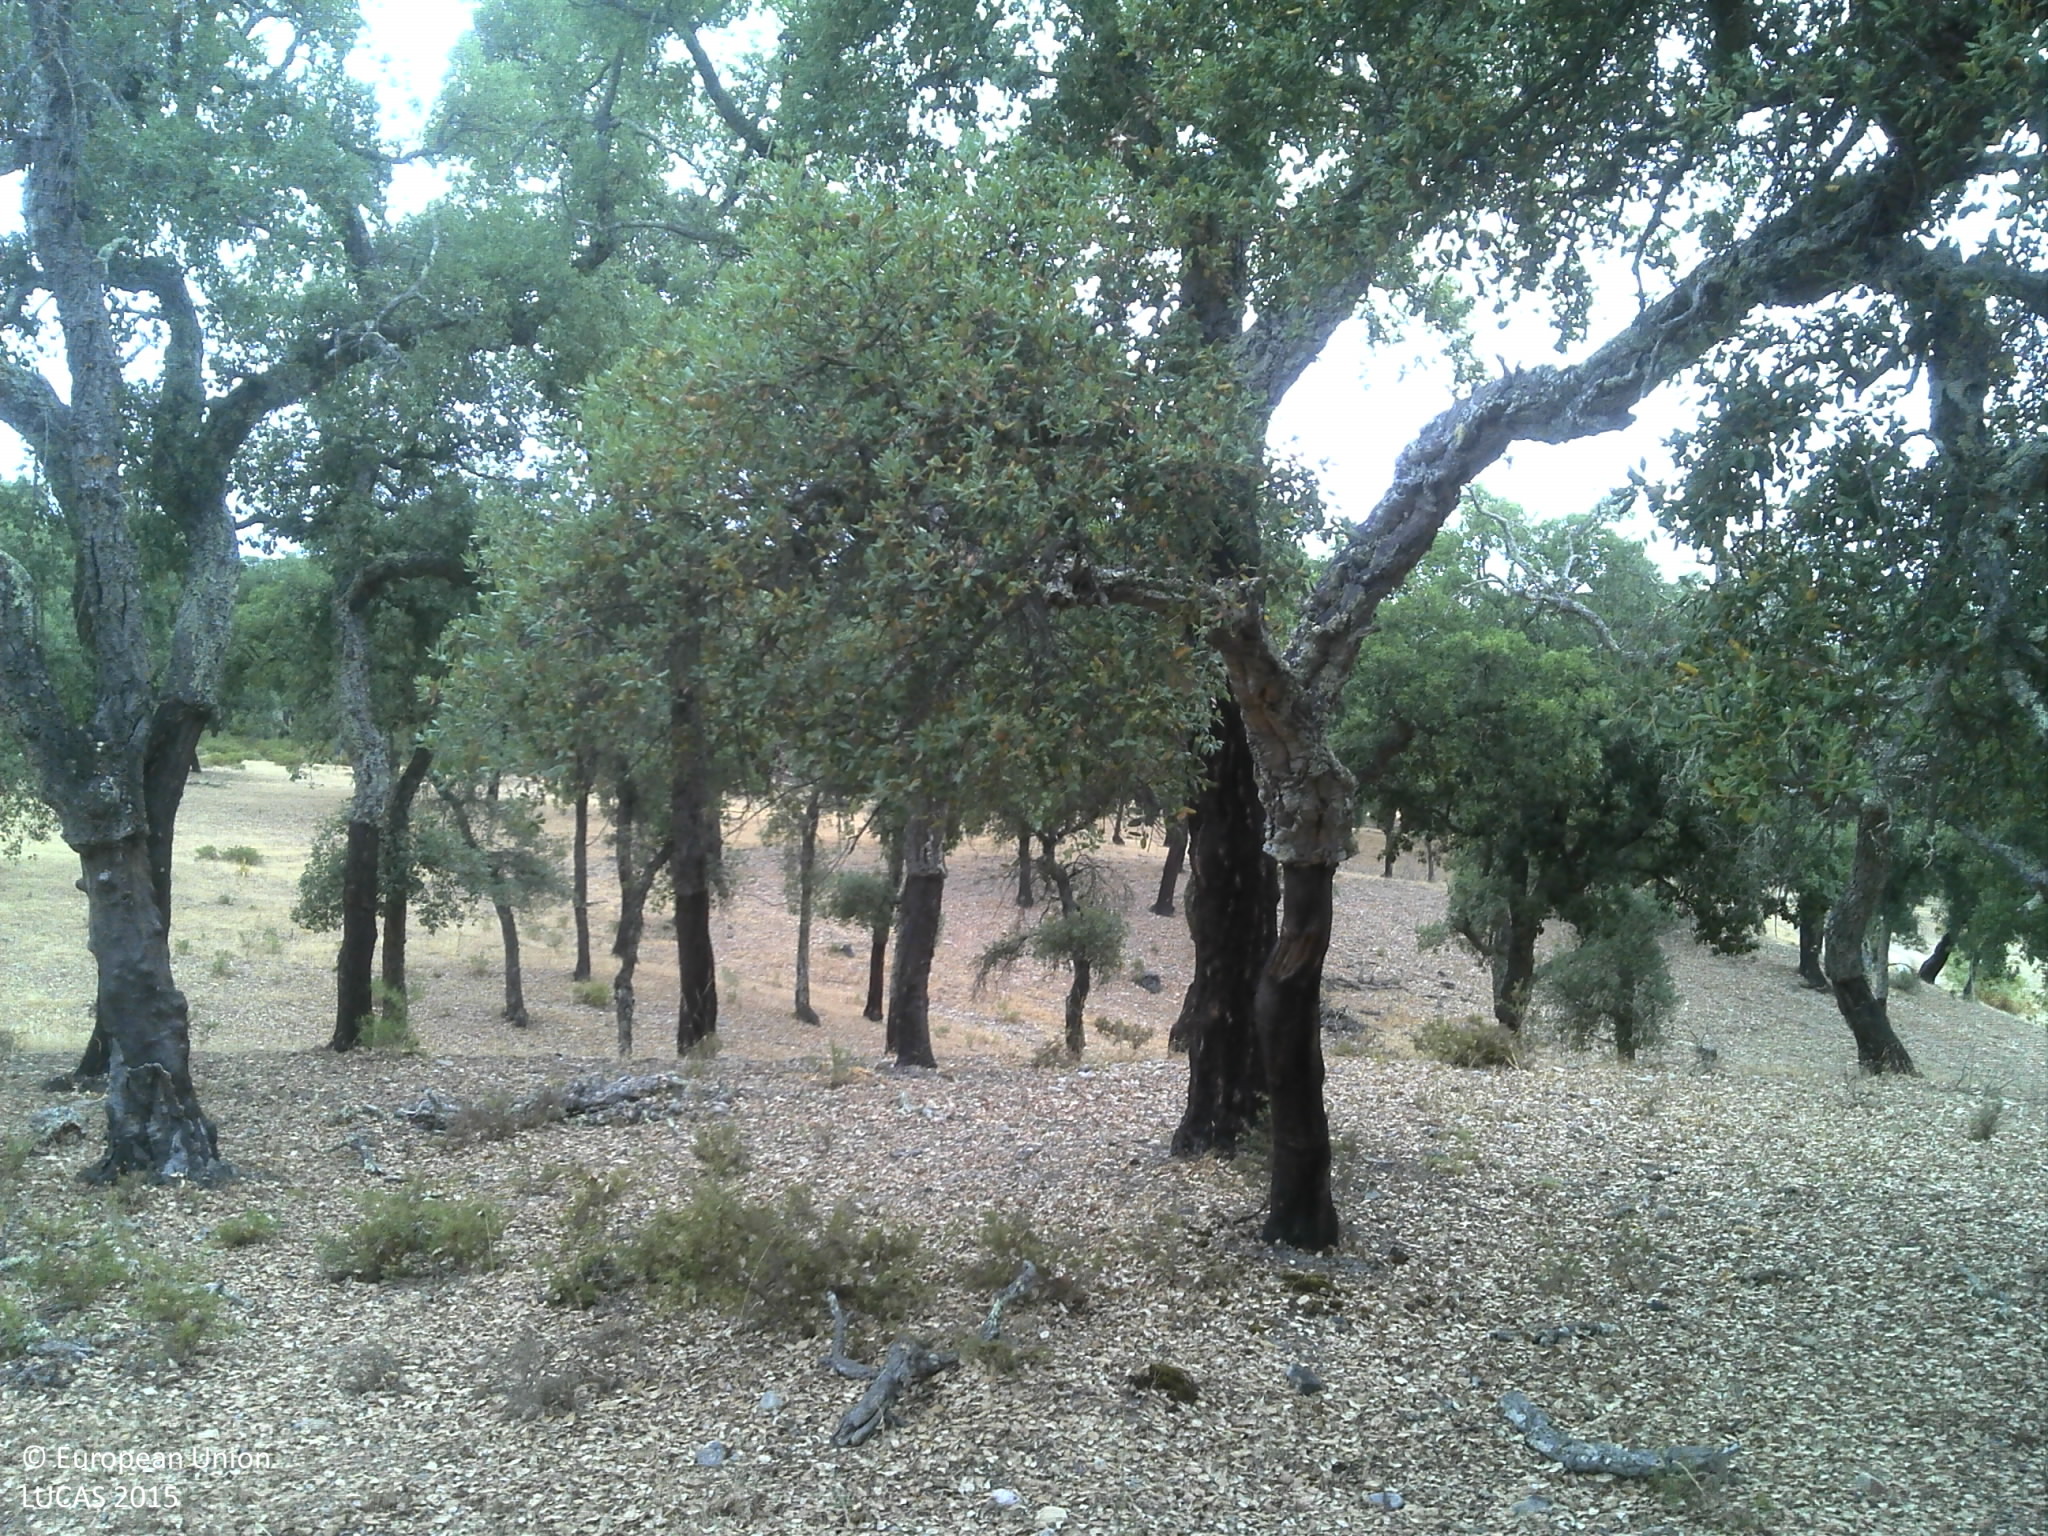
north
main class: Woodland
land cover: Broadleaved woodland
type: broadleaved evergreen forest
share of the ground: 25 - 50 %
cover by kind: broadleaved forest trees 50 %, unconsolidated bare surface 35 %, shrubs 10 %, herbaceous plants 5 %
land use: Forestry
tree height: > 5 m
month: June
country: PT
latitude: 39.3218
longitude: -8.0240
